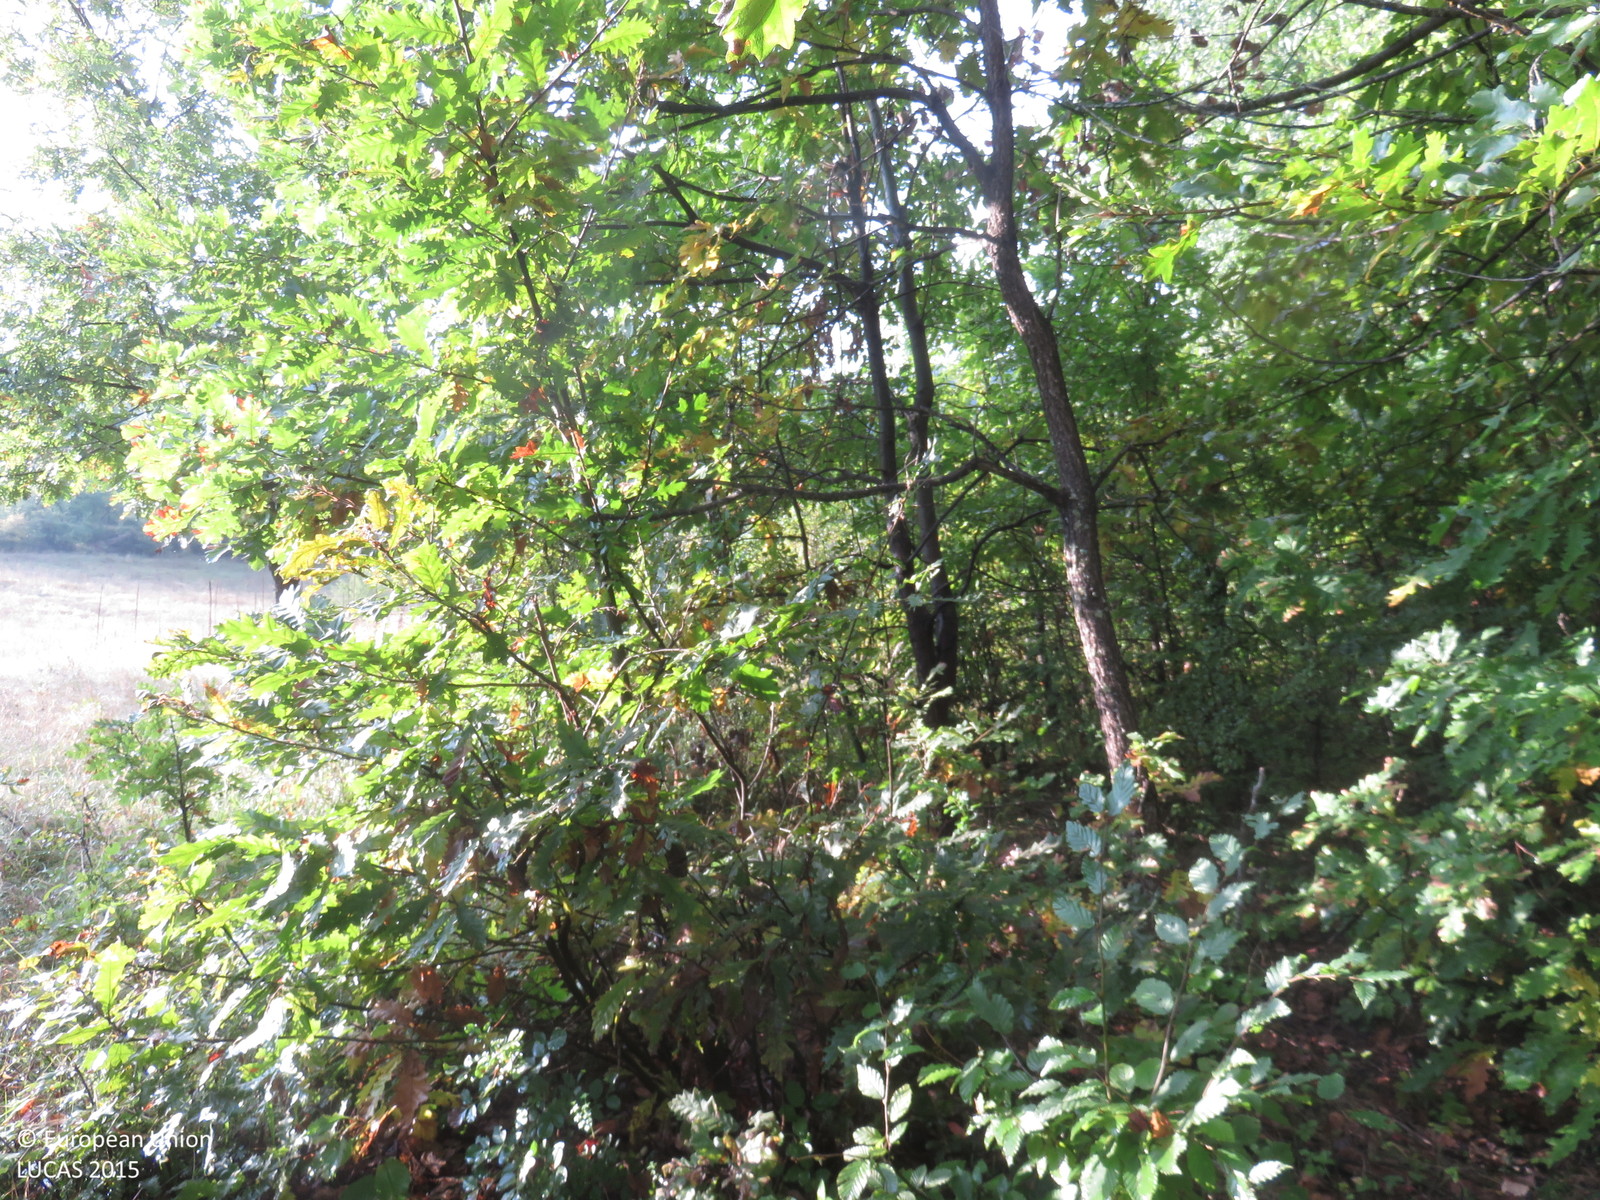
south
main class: Woodland
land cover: Broadleaved woodland
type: mesophytic deciduous forest
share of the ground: > 75 %
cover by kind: broadleaved forest trees 90 %, shrubs 5 %, herbaceous plants 5 %
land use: Forestry
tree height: > 5 m
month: October
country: BG
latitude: 42.8766
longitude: 25.1874
